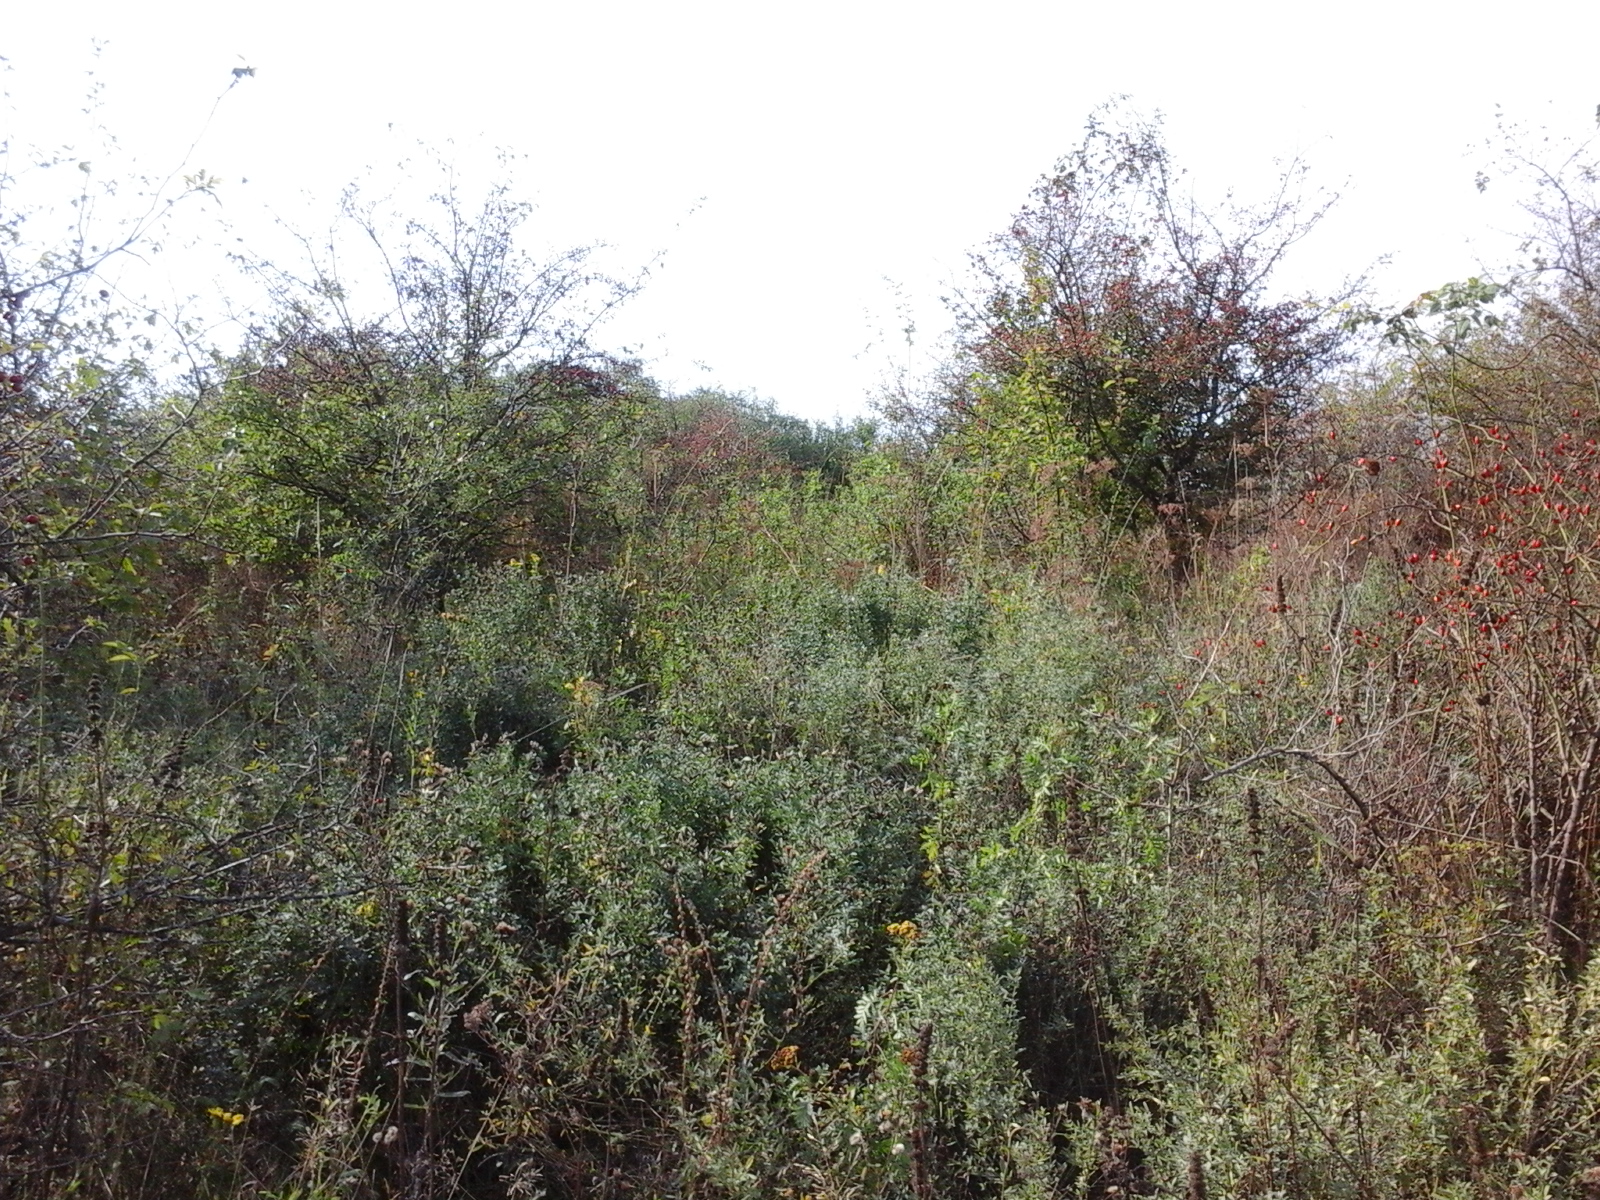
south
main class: Grassland
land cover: Grassland without tree/shrub cover
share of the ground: > 75 %
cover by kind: herbaceous plants 100 %
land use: Agriculture (excluding fallow land and kitchen gardens)
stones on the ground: < 10 %
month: September
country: RO
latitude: 46.9951
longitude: 24.0060
